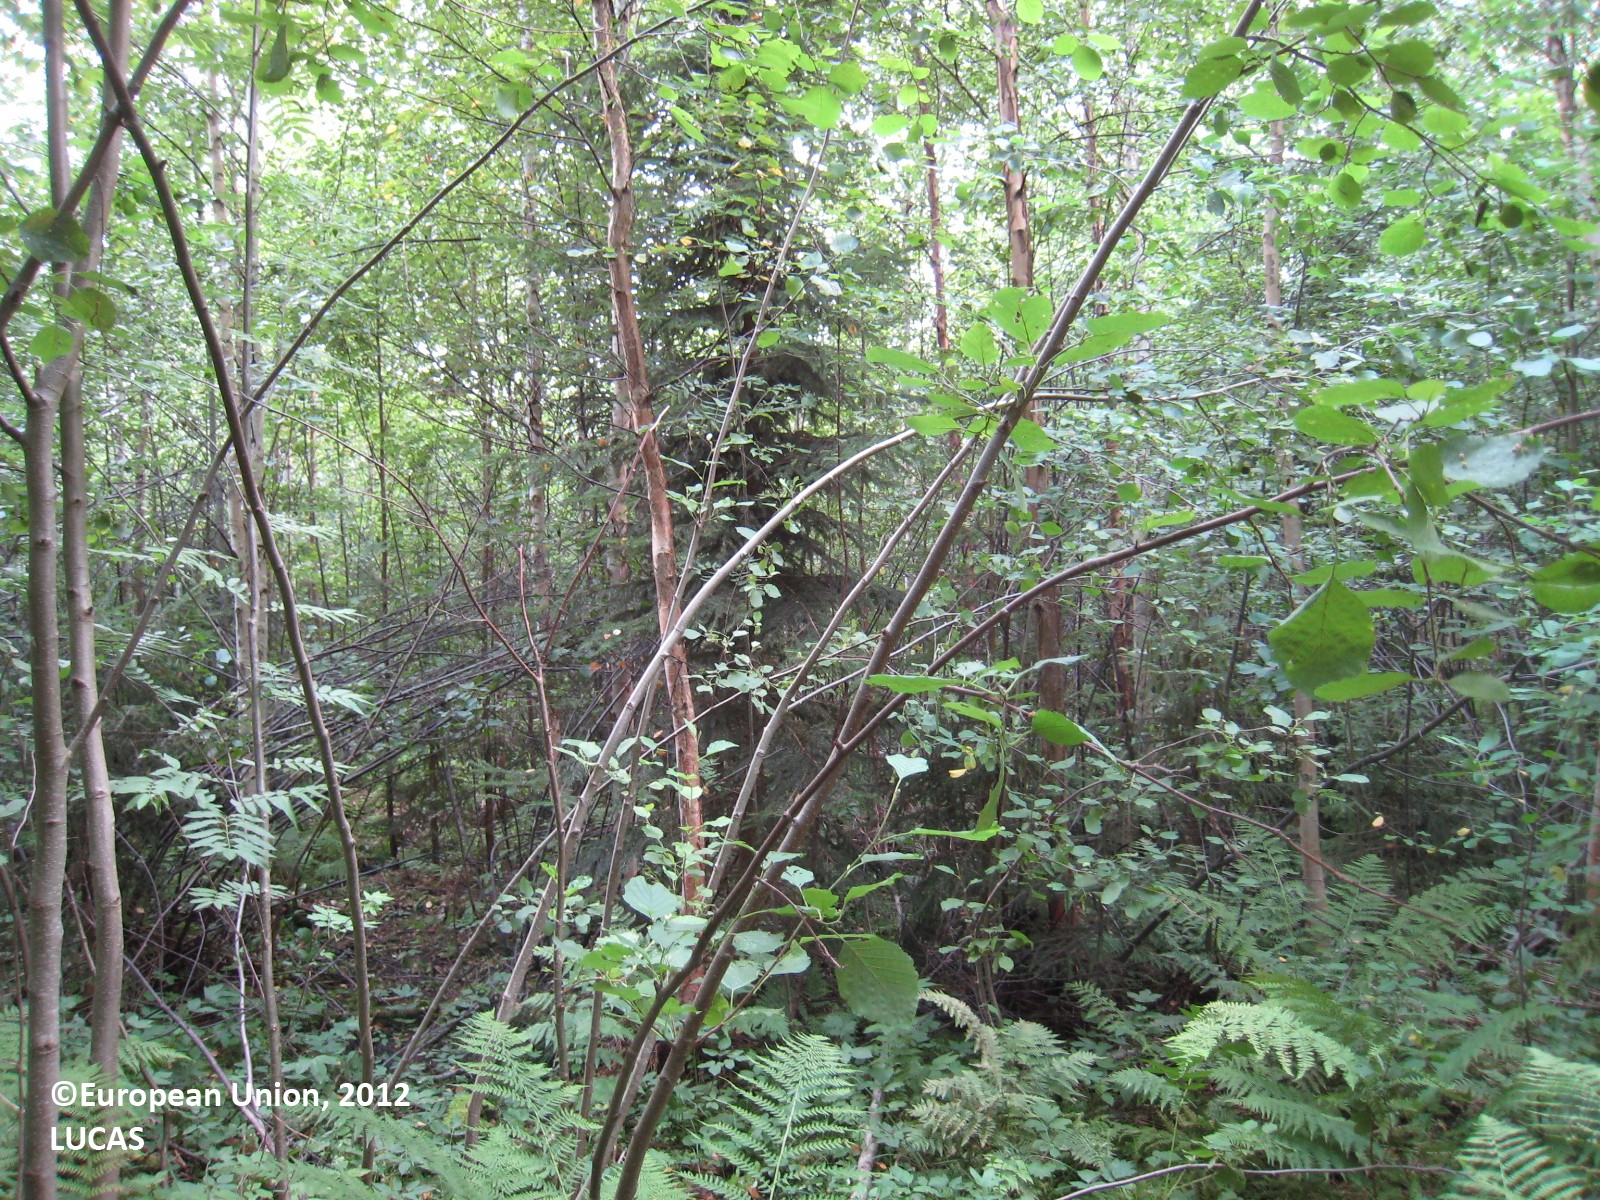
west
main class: Woodland
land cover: Broadleaved woodland
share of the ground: > 75 %
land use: Forestry
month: July
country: FI
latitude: 61.6988
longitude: 26.1117
